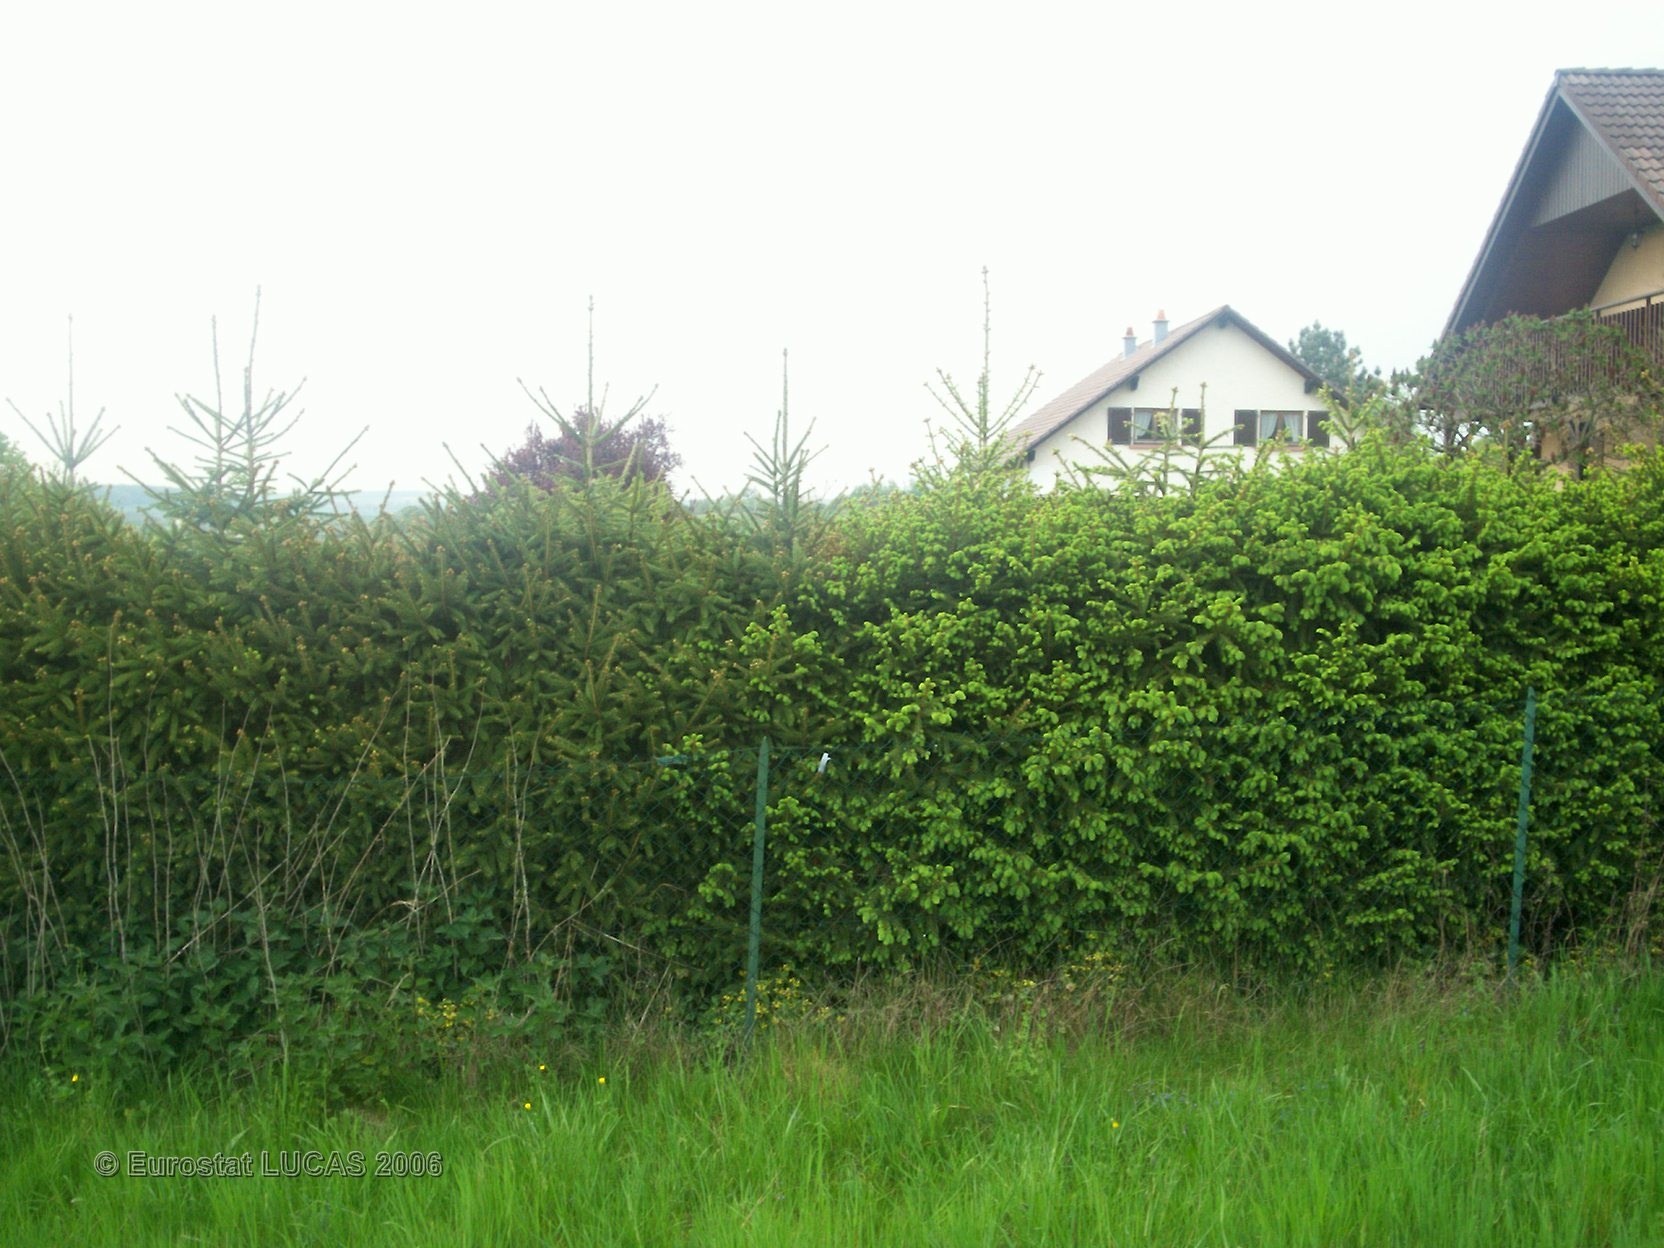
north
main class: Grassland
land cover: Grassland with sparse tree/shrub cover
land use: Agriculture (excluding fallow land and kitchen gardens)
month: May
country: FR
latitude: 48.7775
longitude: 7.0204
